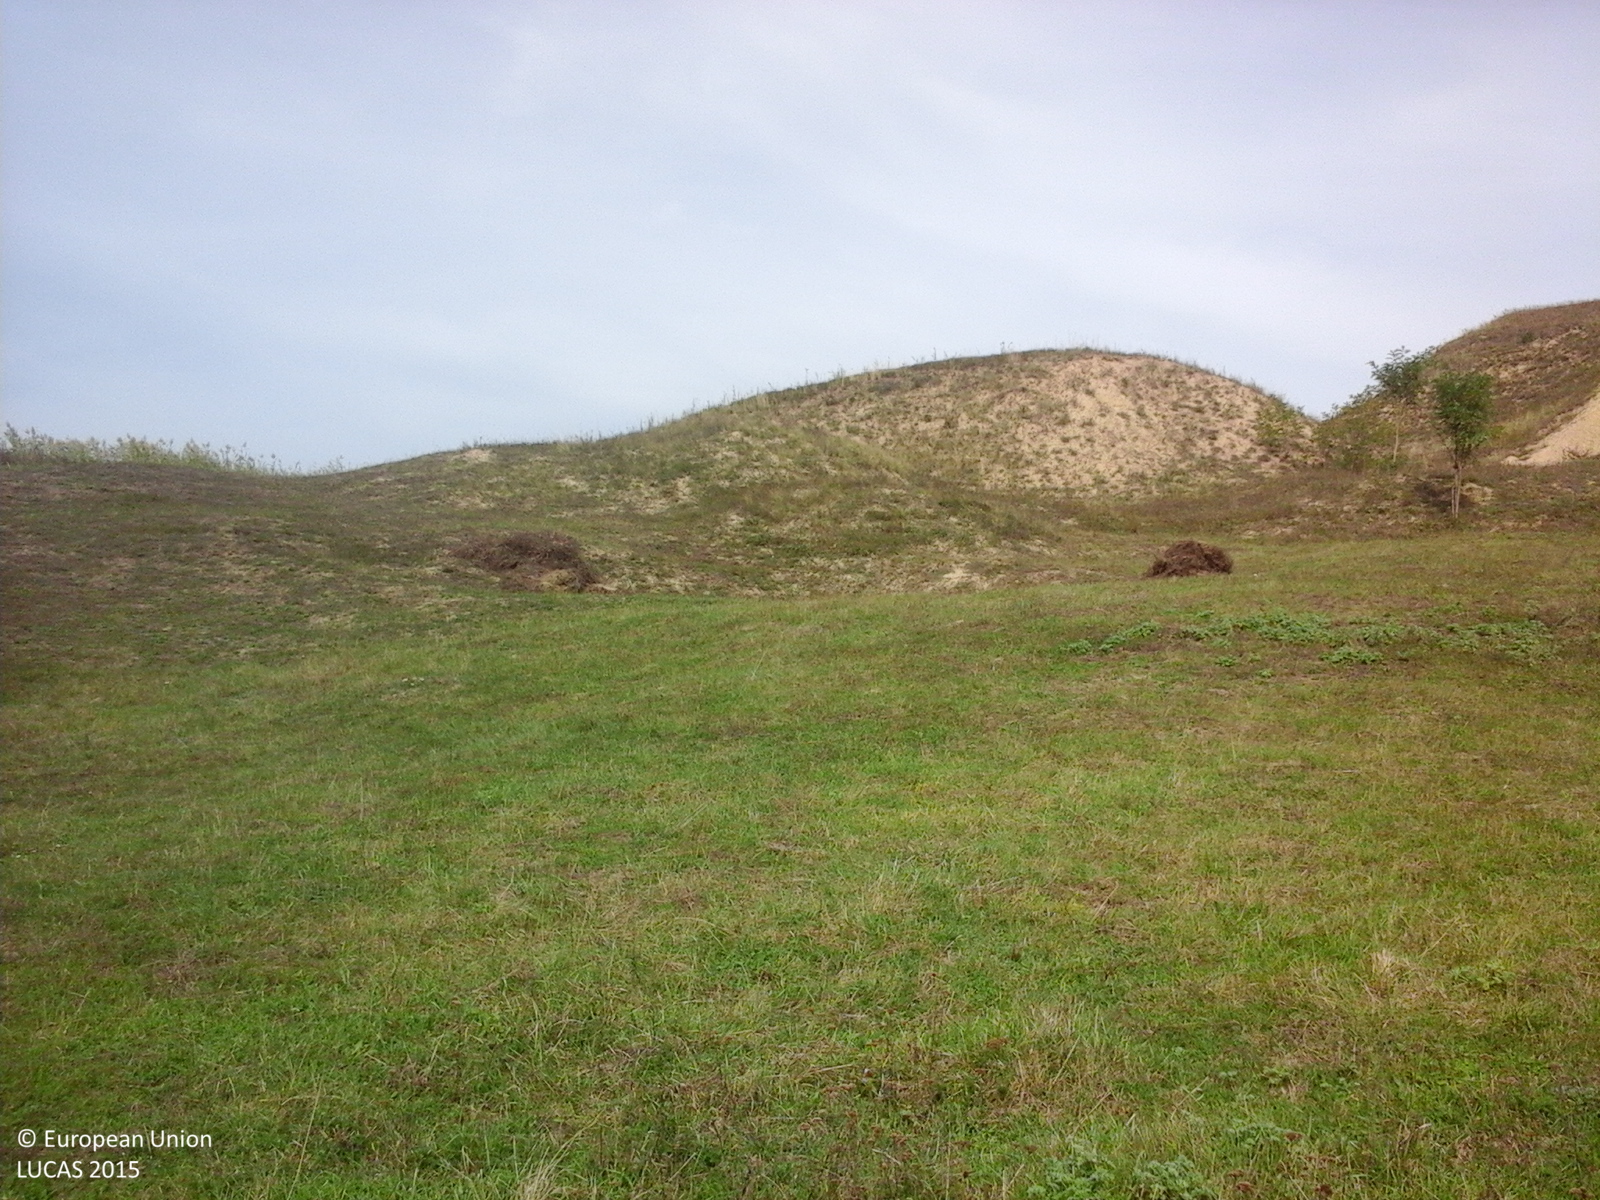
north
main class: Grassland
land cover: Grassland without tree/shrub cover
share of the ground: > 75 %
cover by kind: herbaceous plants 100 %
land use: Agriculture (excluding fallow land and kitchen gardens)
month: September
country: RO
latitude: 46.8268
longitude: 24.1745
